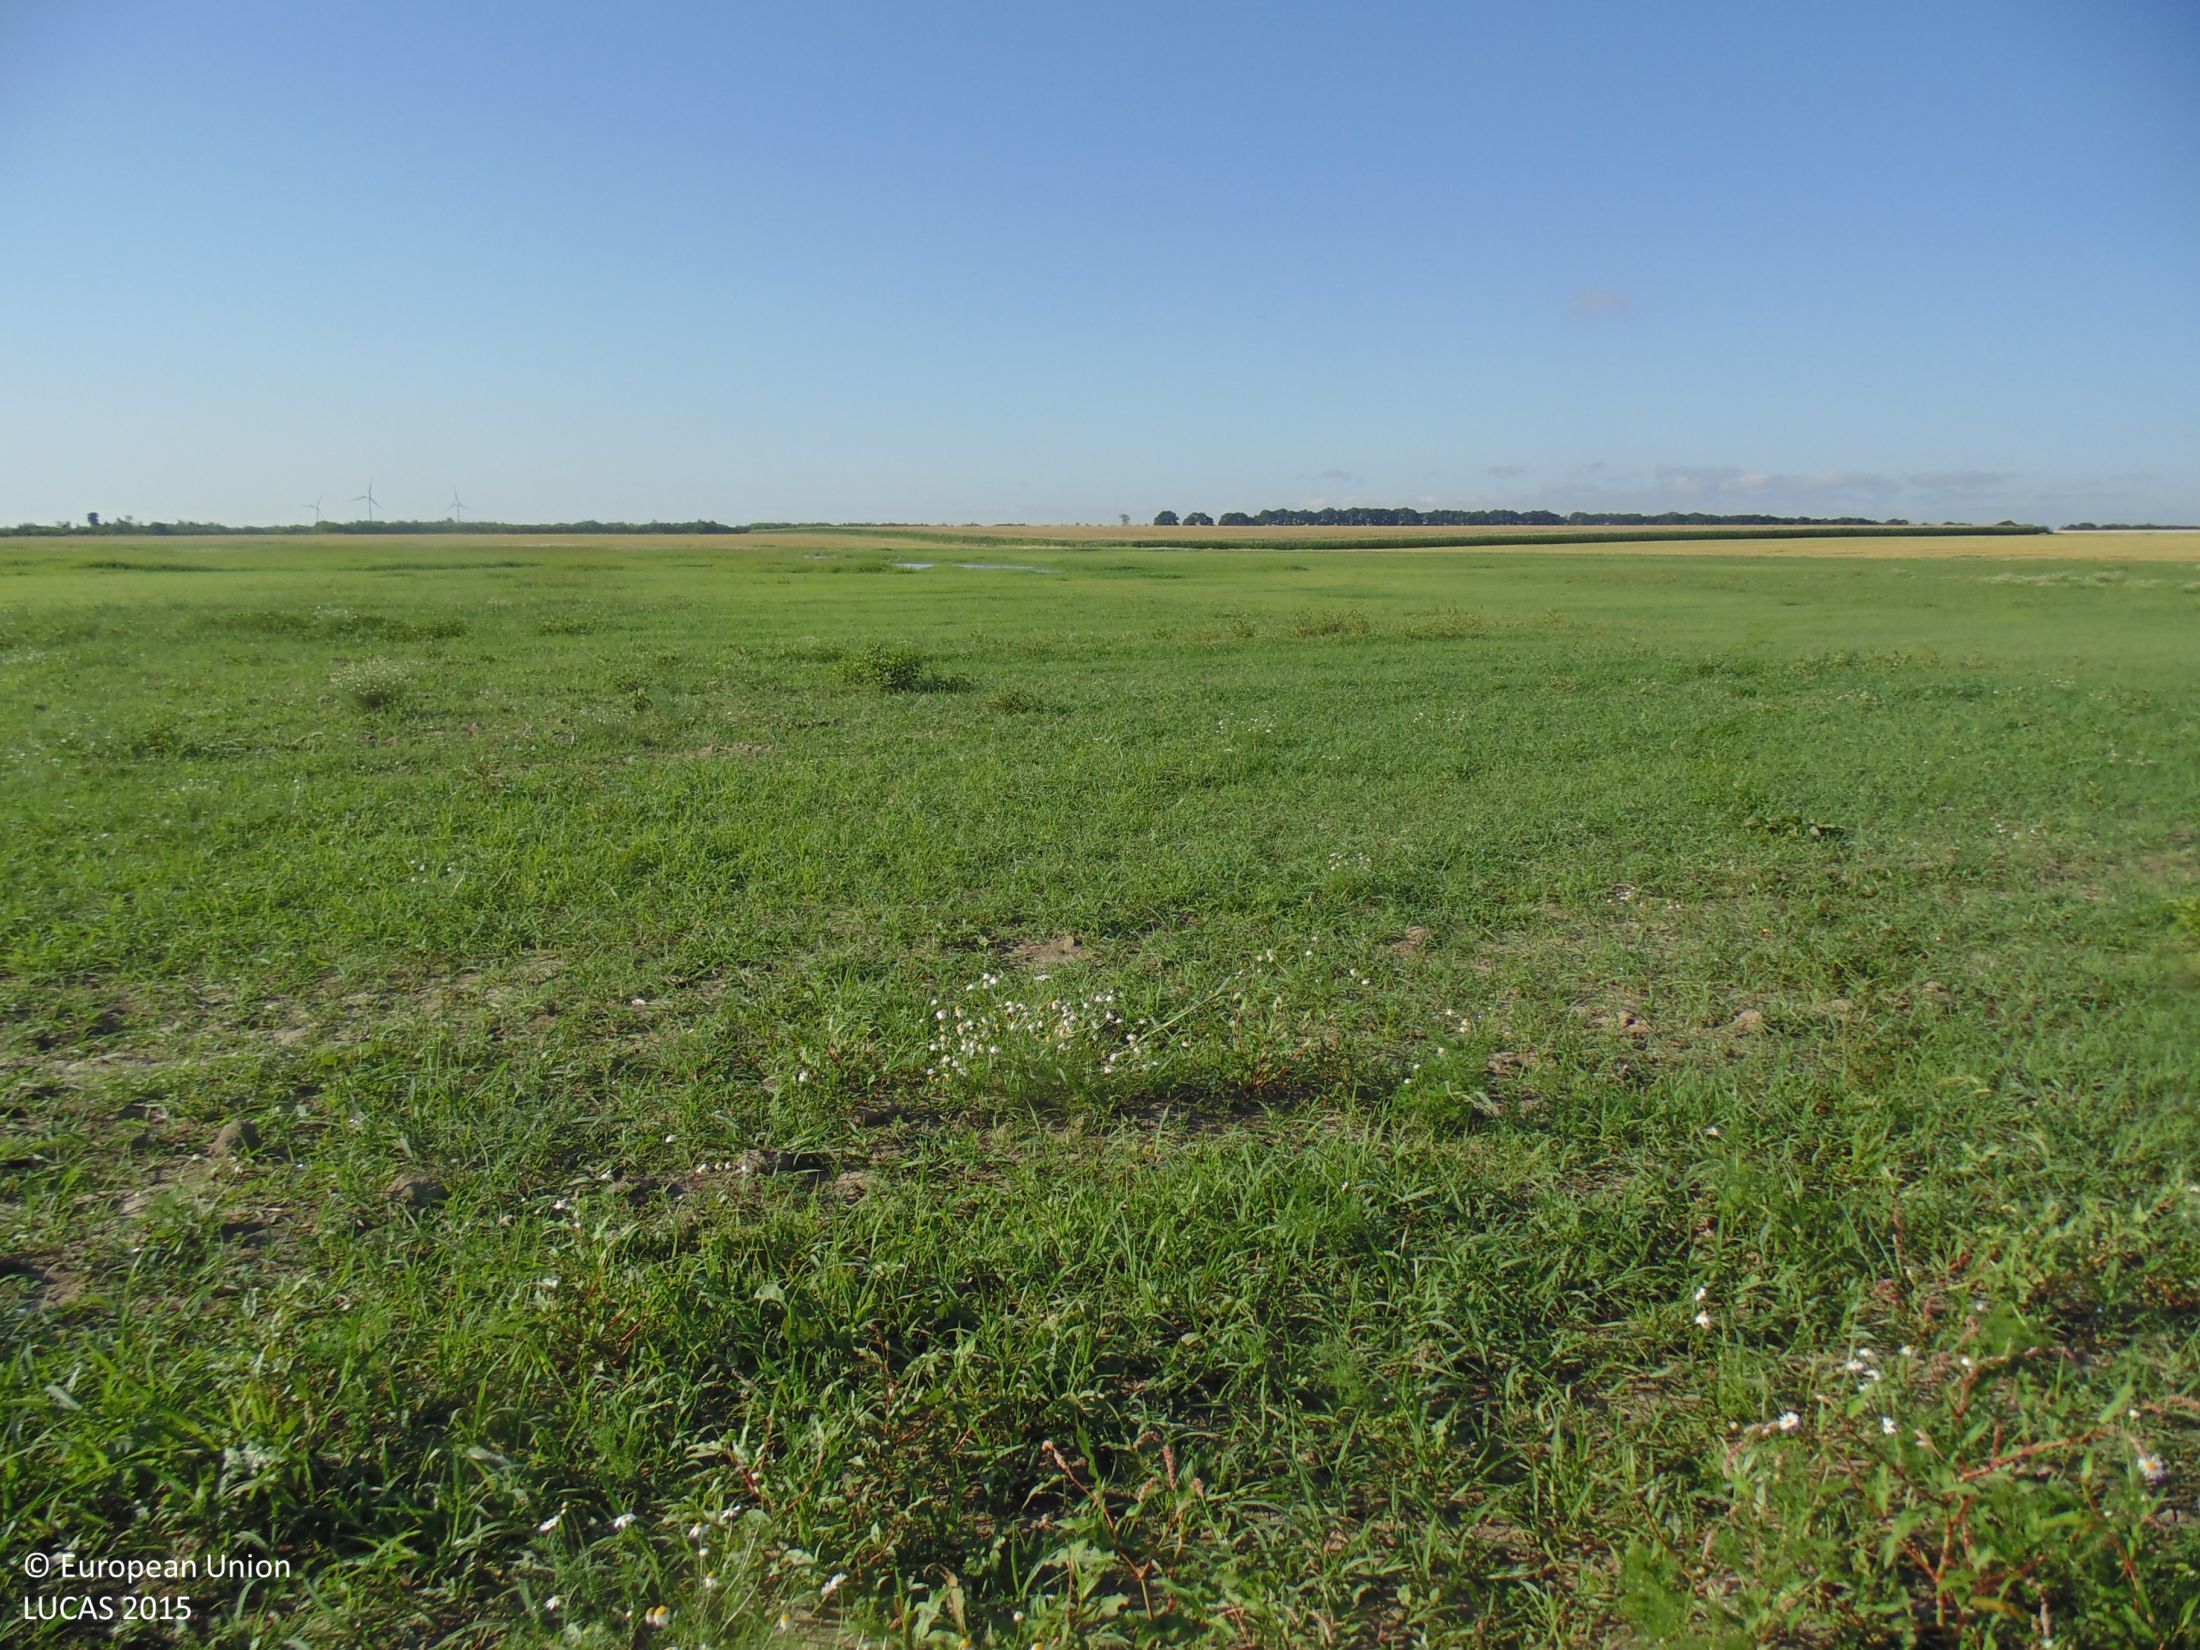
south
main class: Grassland
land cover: Spontaneously vegetated surfaces
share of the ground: > 75 %
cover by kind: herbaceous plants 80 %, unconsolidated bare surface 20 %
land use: Fallow land
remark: Temporary dry
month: July
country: BG
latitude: 43.4867
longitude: 27.9619
